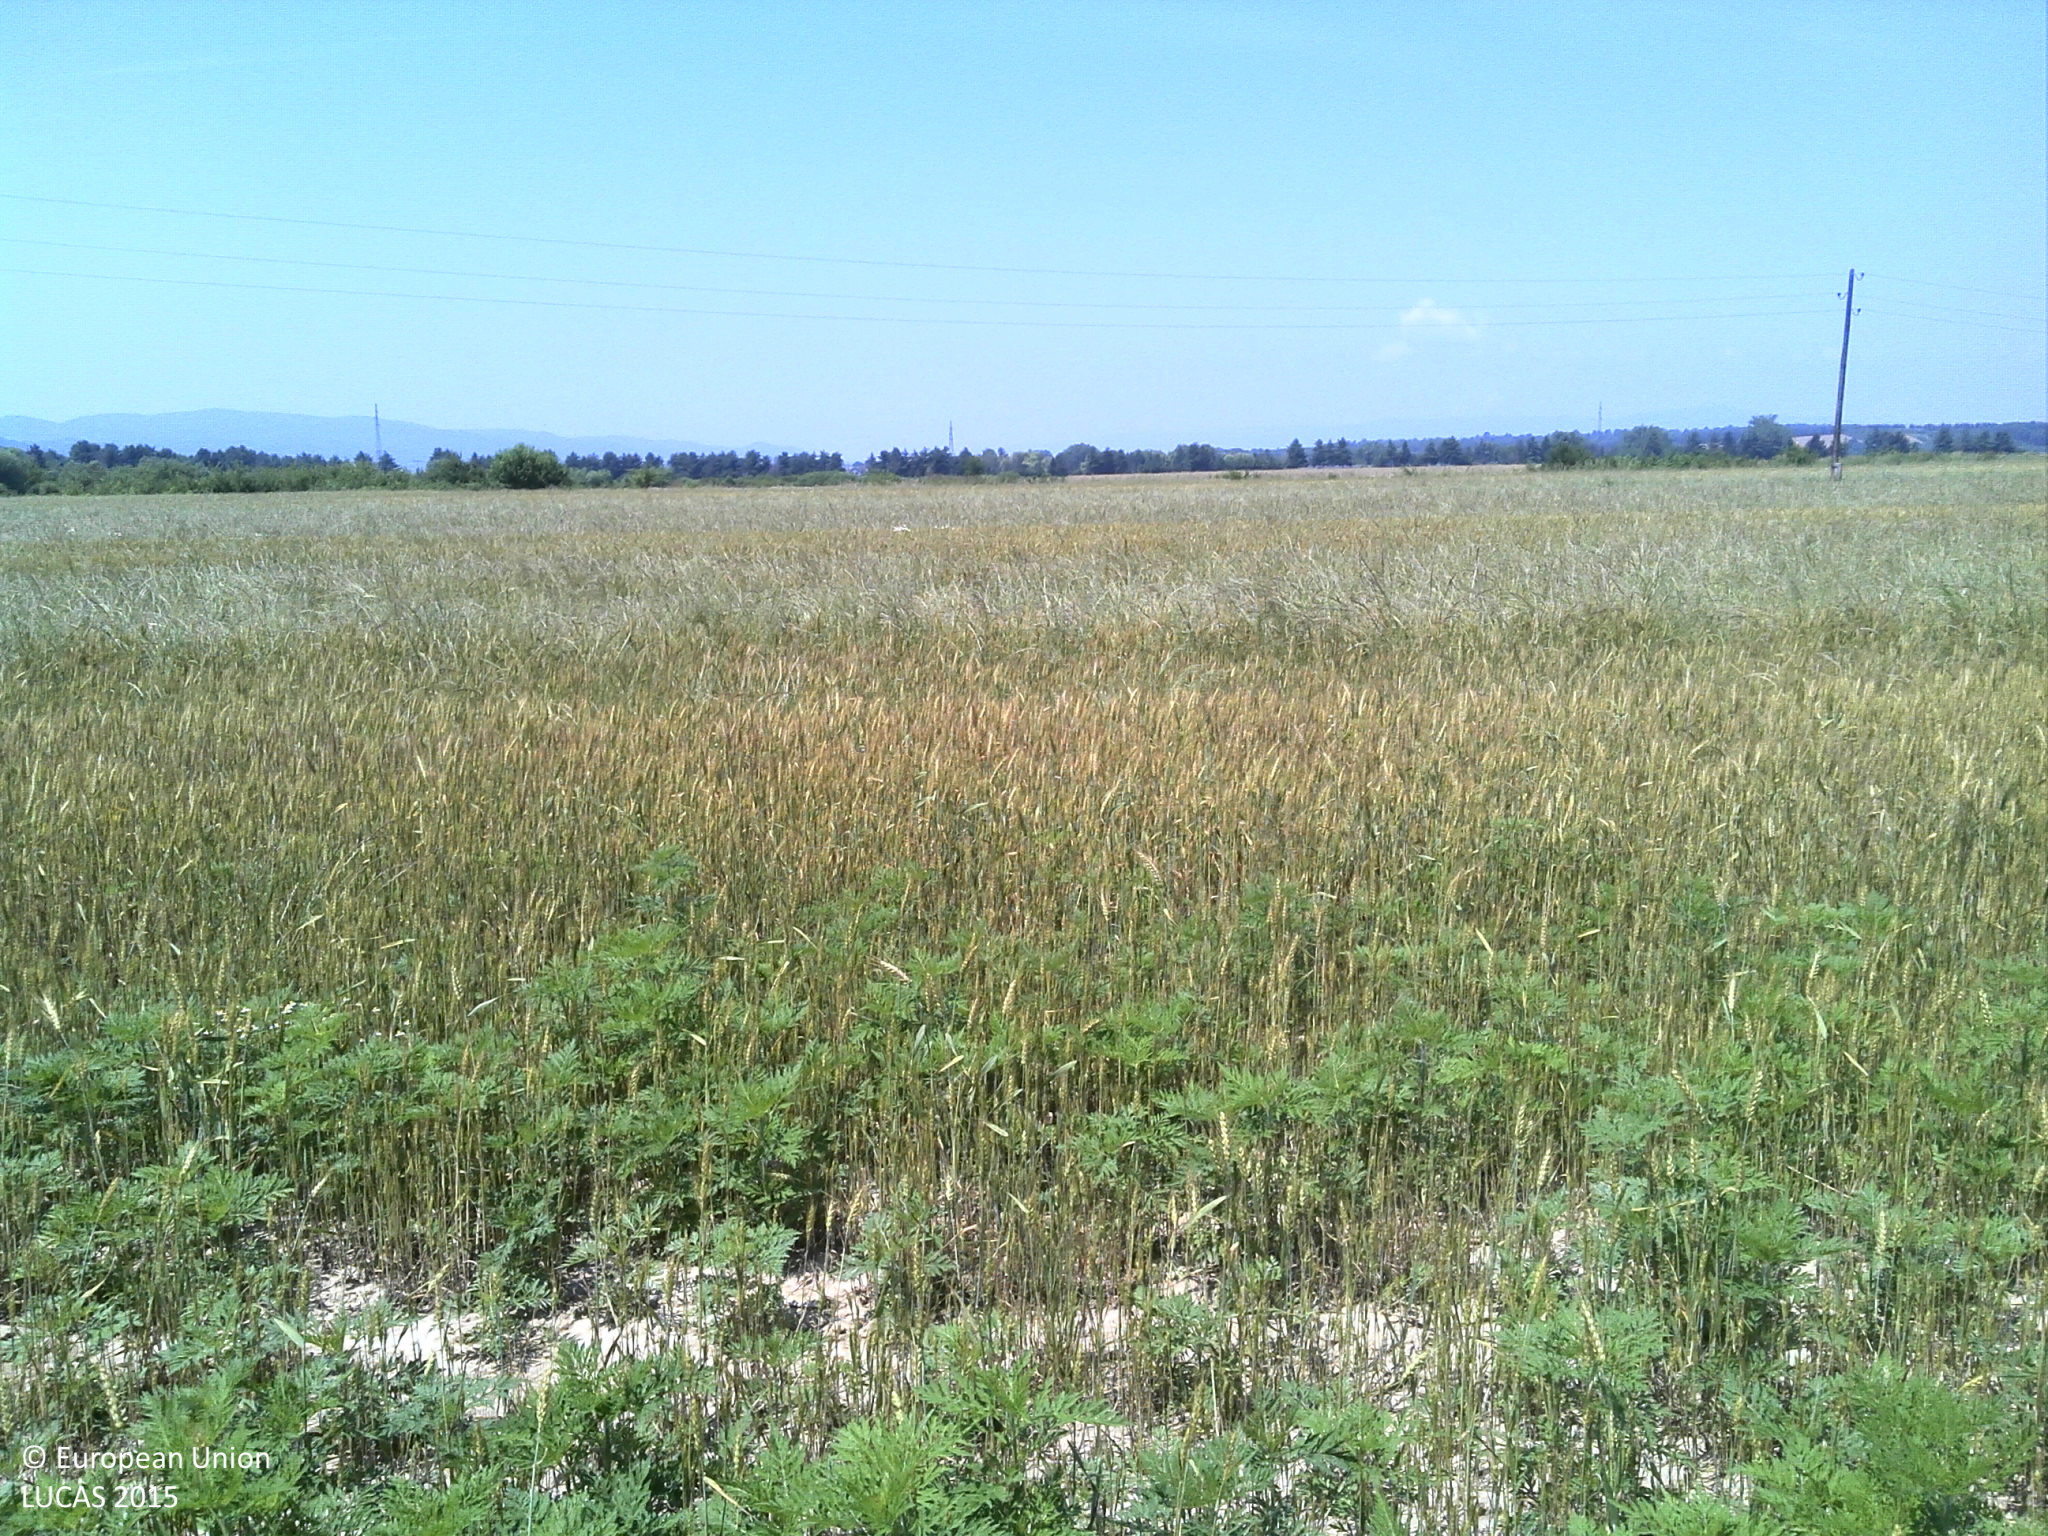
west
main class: Cropland
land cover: Barley
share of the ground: > 75 %
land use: Agriculture (excluding fallow land and kitchen gardens)
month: June
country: HR
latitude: 45.3498
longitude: 17.6983
